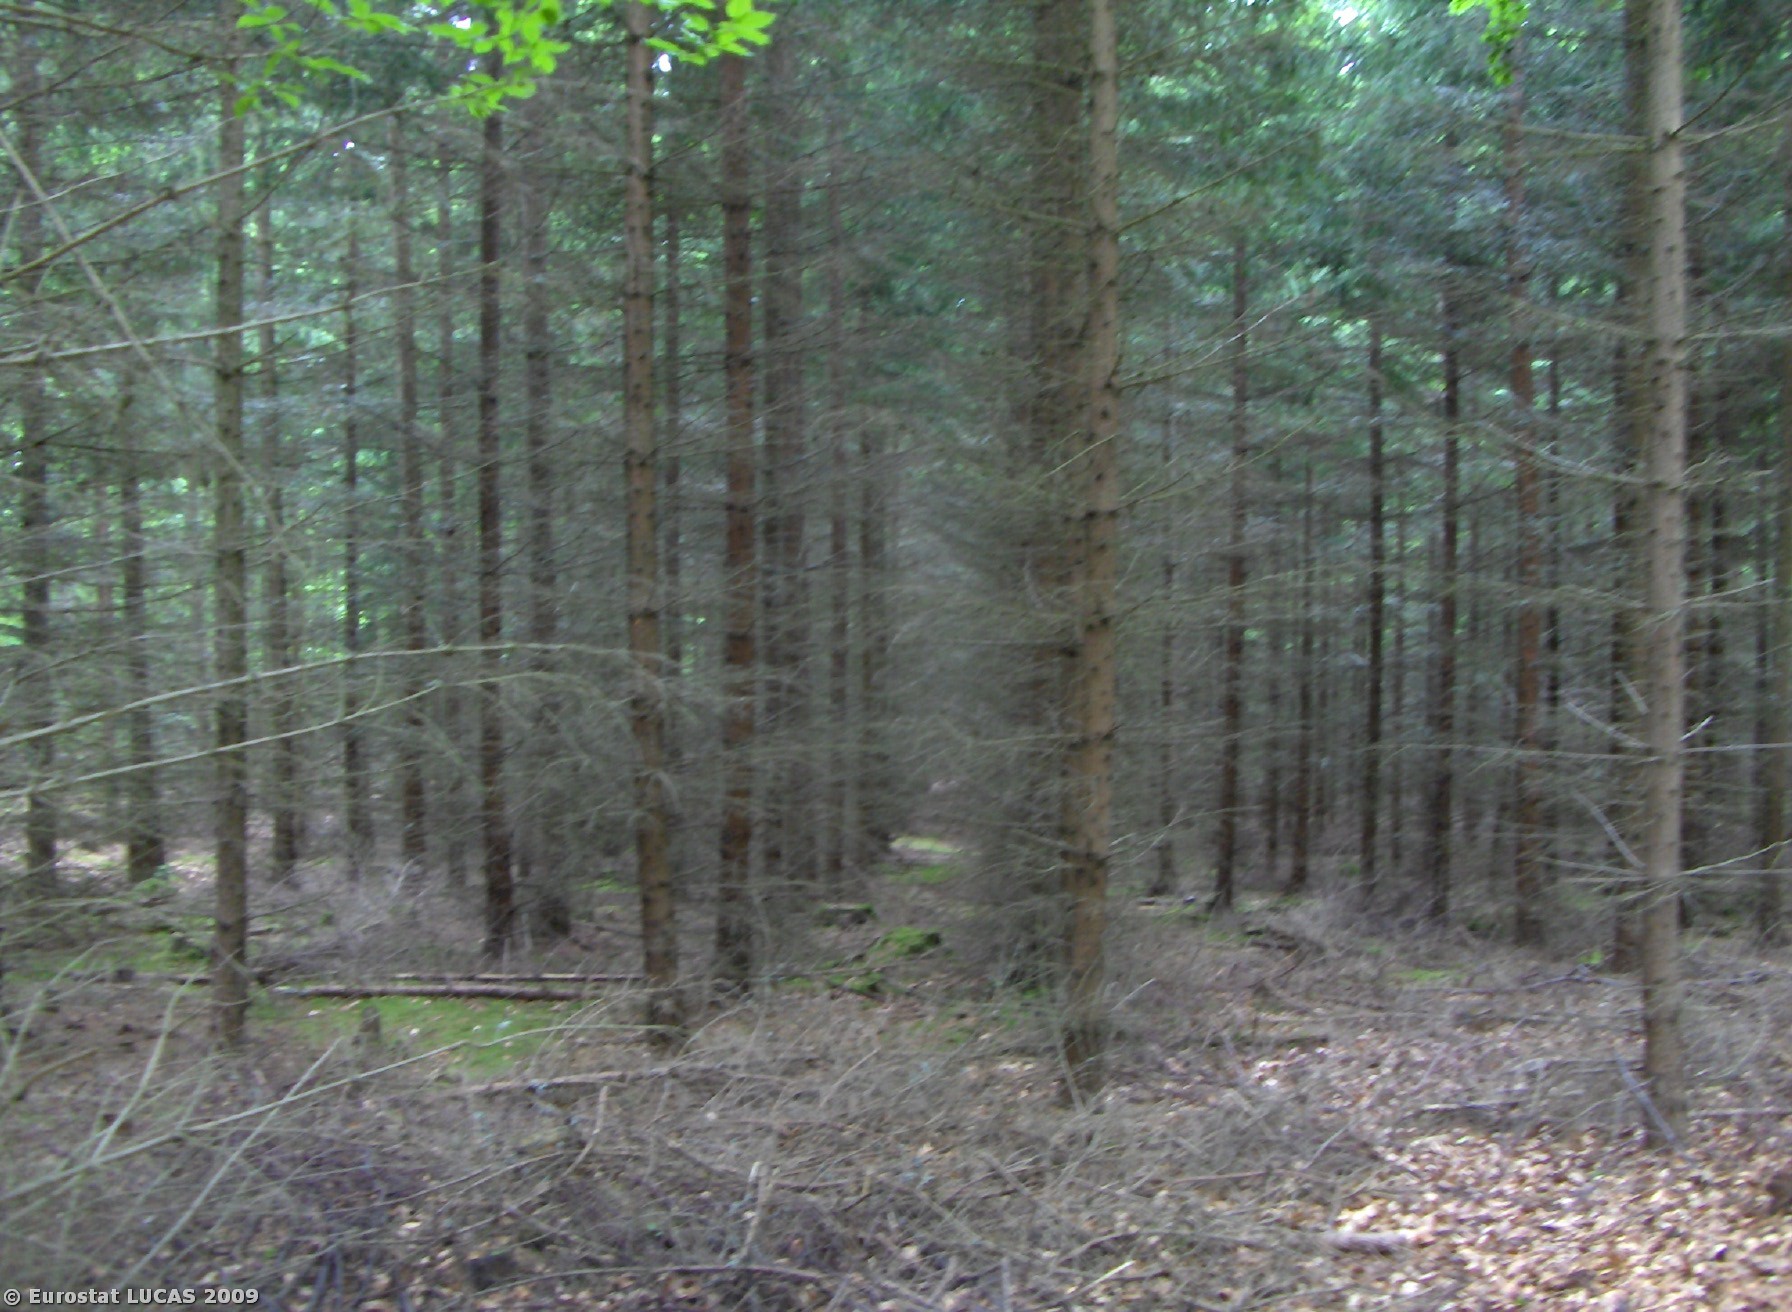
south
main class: Woodland
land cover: Mixed woodland
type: hemiboreal forest and nemoral coniferous forest and mixed broadleaved-coniferous forest
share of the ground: > 75 %
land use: Forestry
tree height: > 5 m
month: May
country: CZ
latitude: 49.2376
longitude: 14.3274
